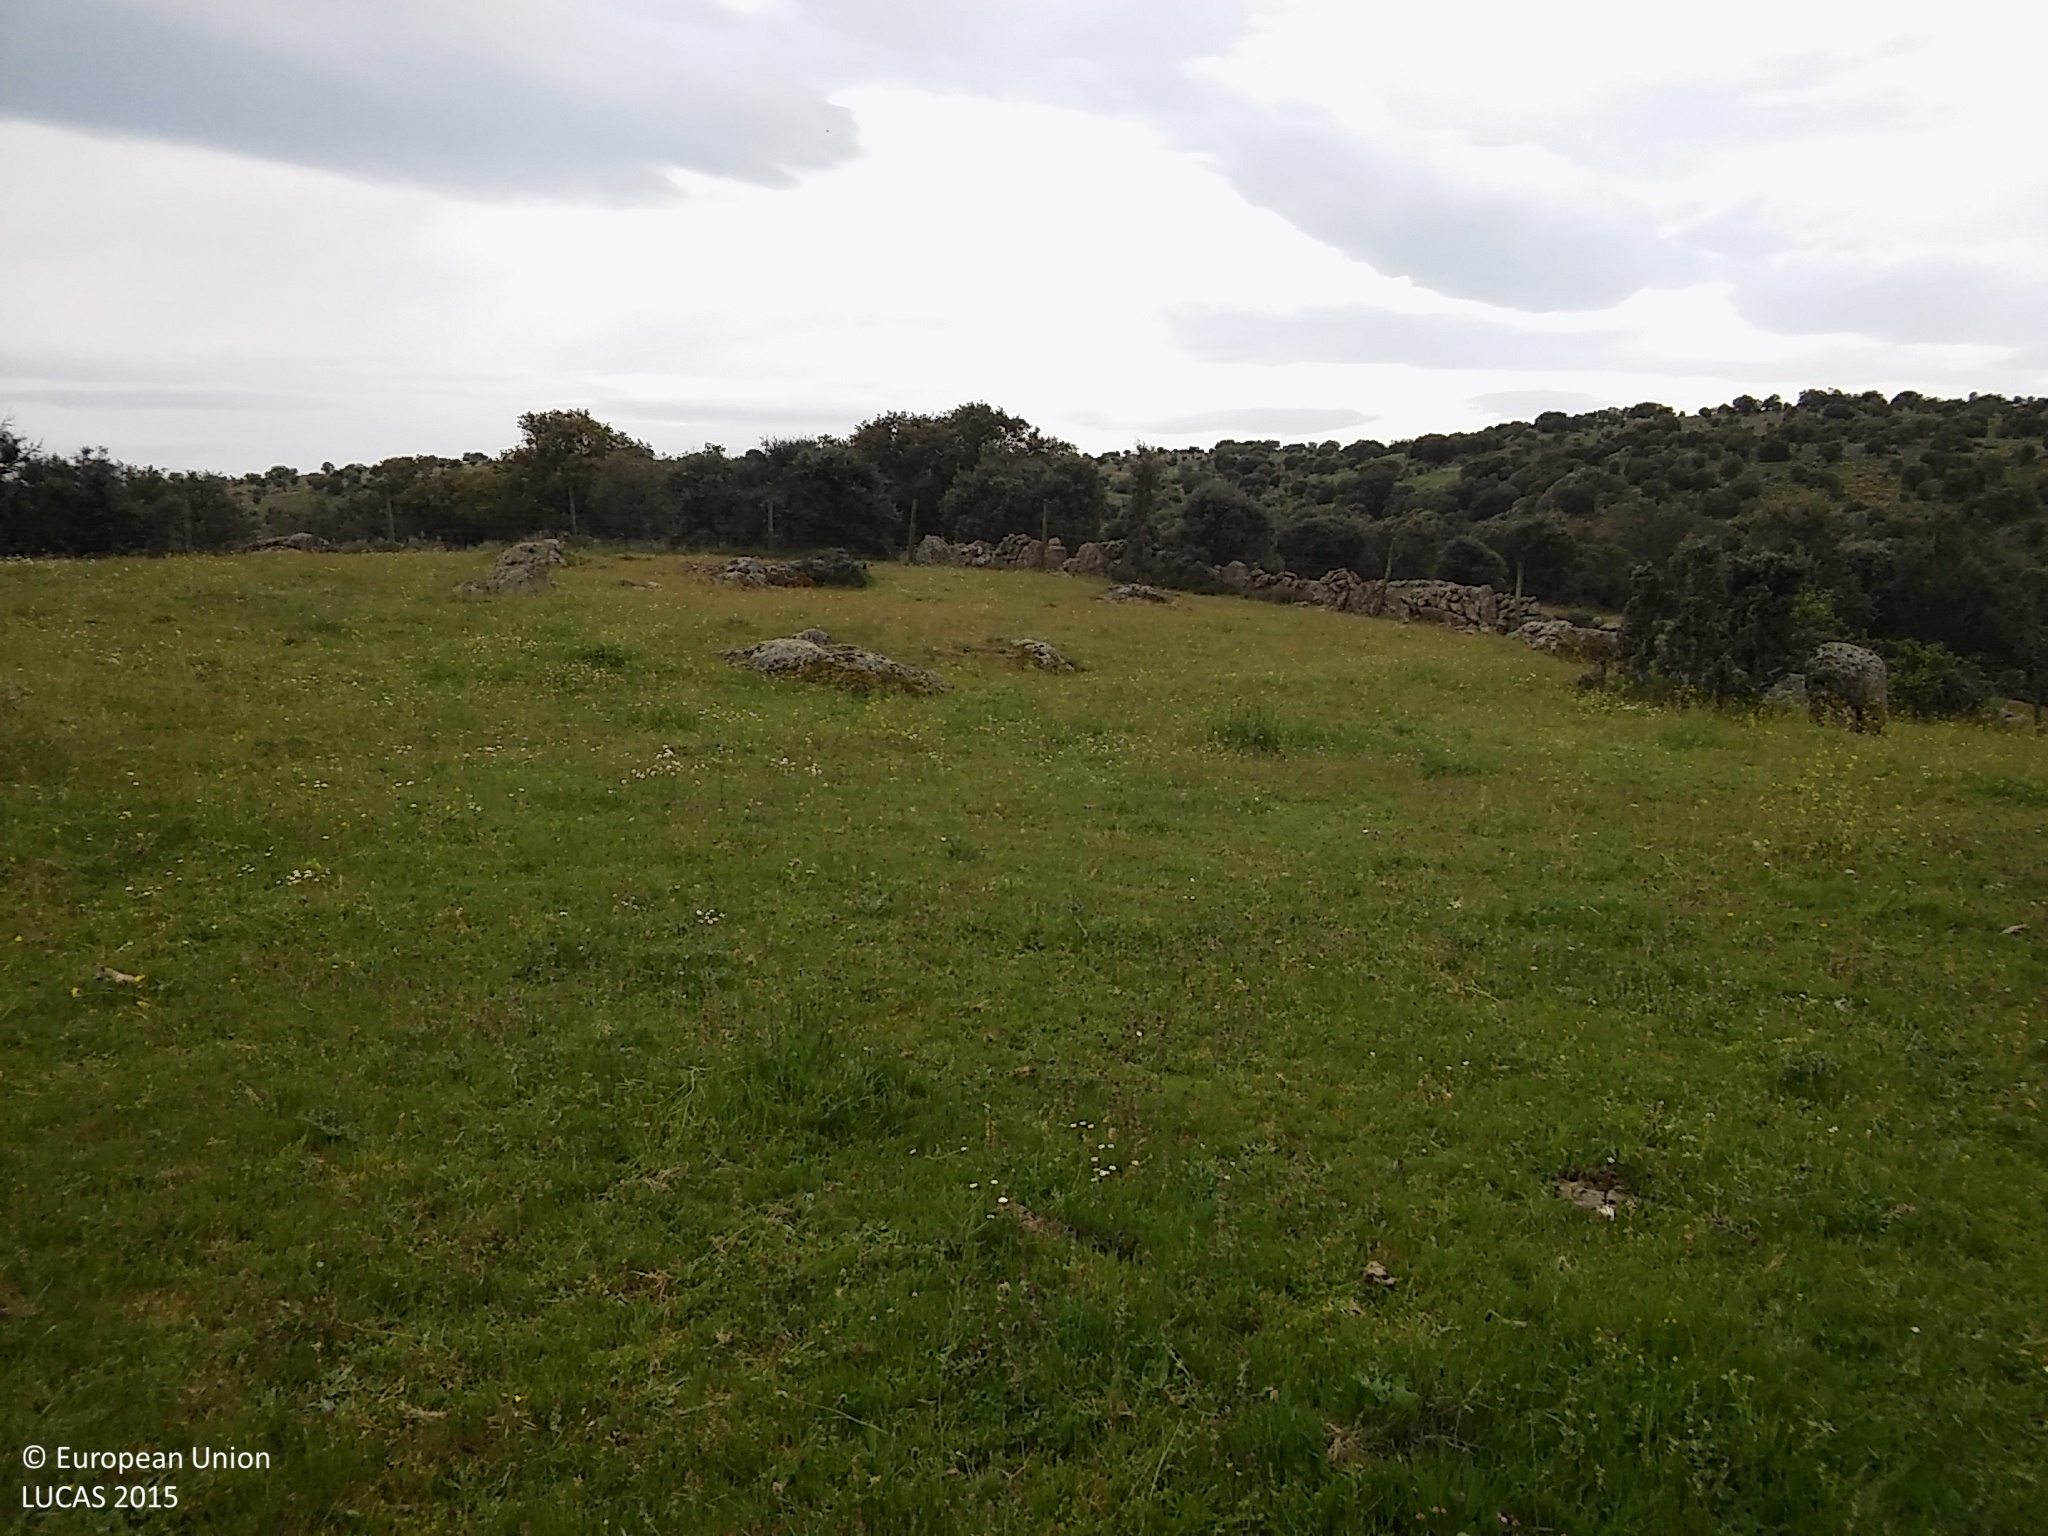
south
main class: Grassland
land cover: Grassland with sparse tree/shrub cover
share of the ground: > 75 %
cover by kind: herbaceous plants 90 %, broadleaved forest trees 5 %, shrubs 5 %
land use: Agriculture (excluding fallow land and kitchen gardens)
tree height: > 5 m
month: May
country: ES
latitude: 41.0673
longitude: -4.0337
